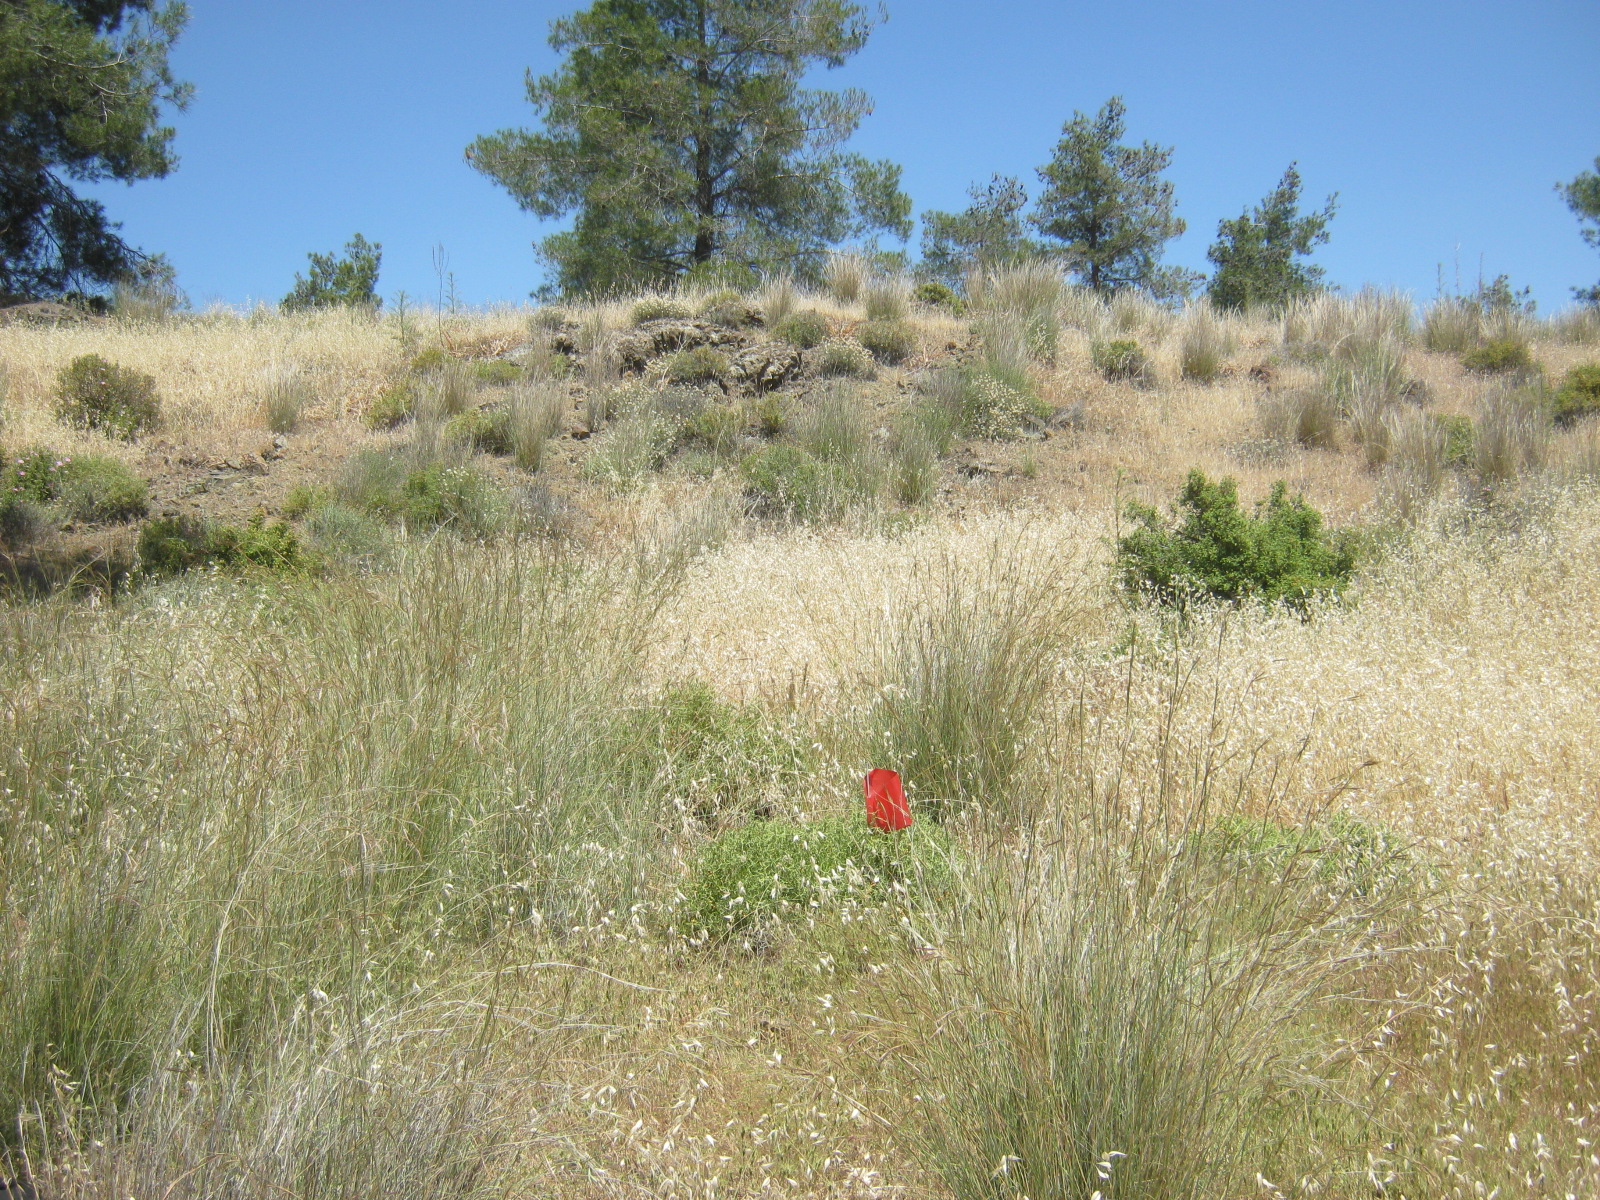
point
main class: Grassland
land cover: Grassland with sparse tree/shrub cover
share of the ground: > 75 %
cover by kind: herbaceous plants 80 %, unconsolidated bare surface 10 %, coniferous forest trees 5 %, shrubs 5 %
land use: Semi-natural and natural areas not in use
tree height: > 5 m
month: May
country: CY
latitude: 35.0044
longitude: 33.2034
